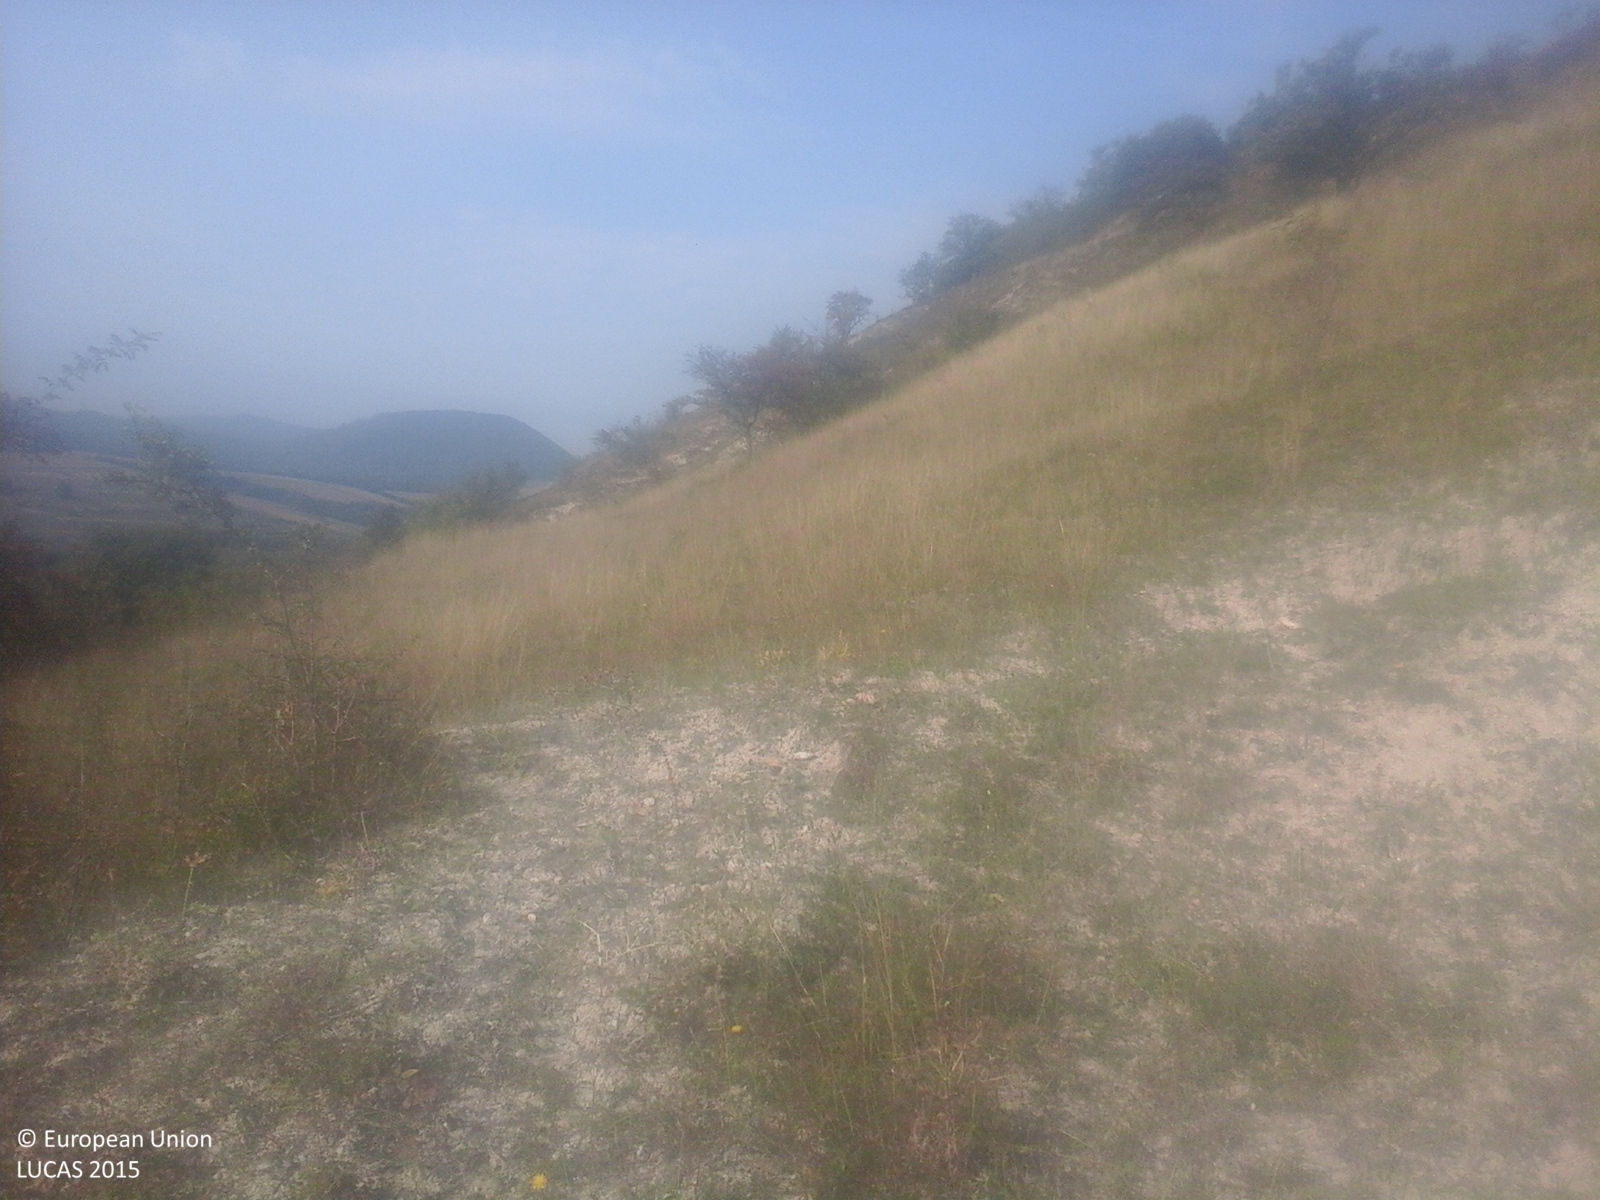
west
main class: Grassland
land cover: Grassland without tree/shrub cover
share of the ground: > 75 %
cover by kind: herbaceous plants 100 %
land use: Agriculture (excluding fallow land and kitchen gardens)
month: September
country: RO
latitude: 47.2064
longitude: 23.2028
